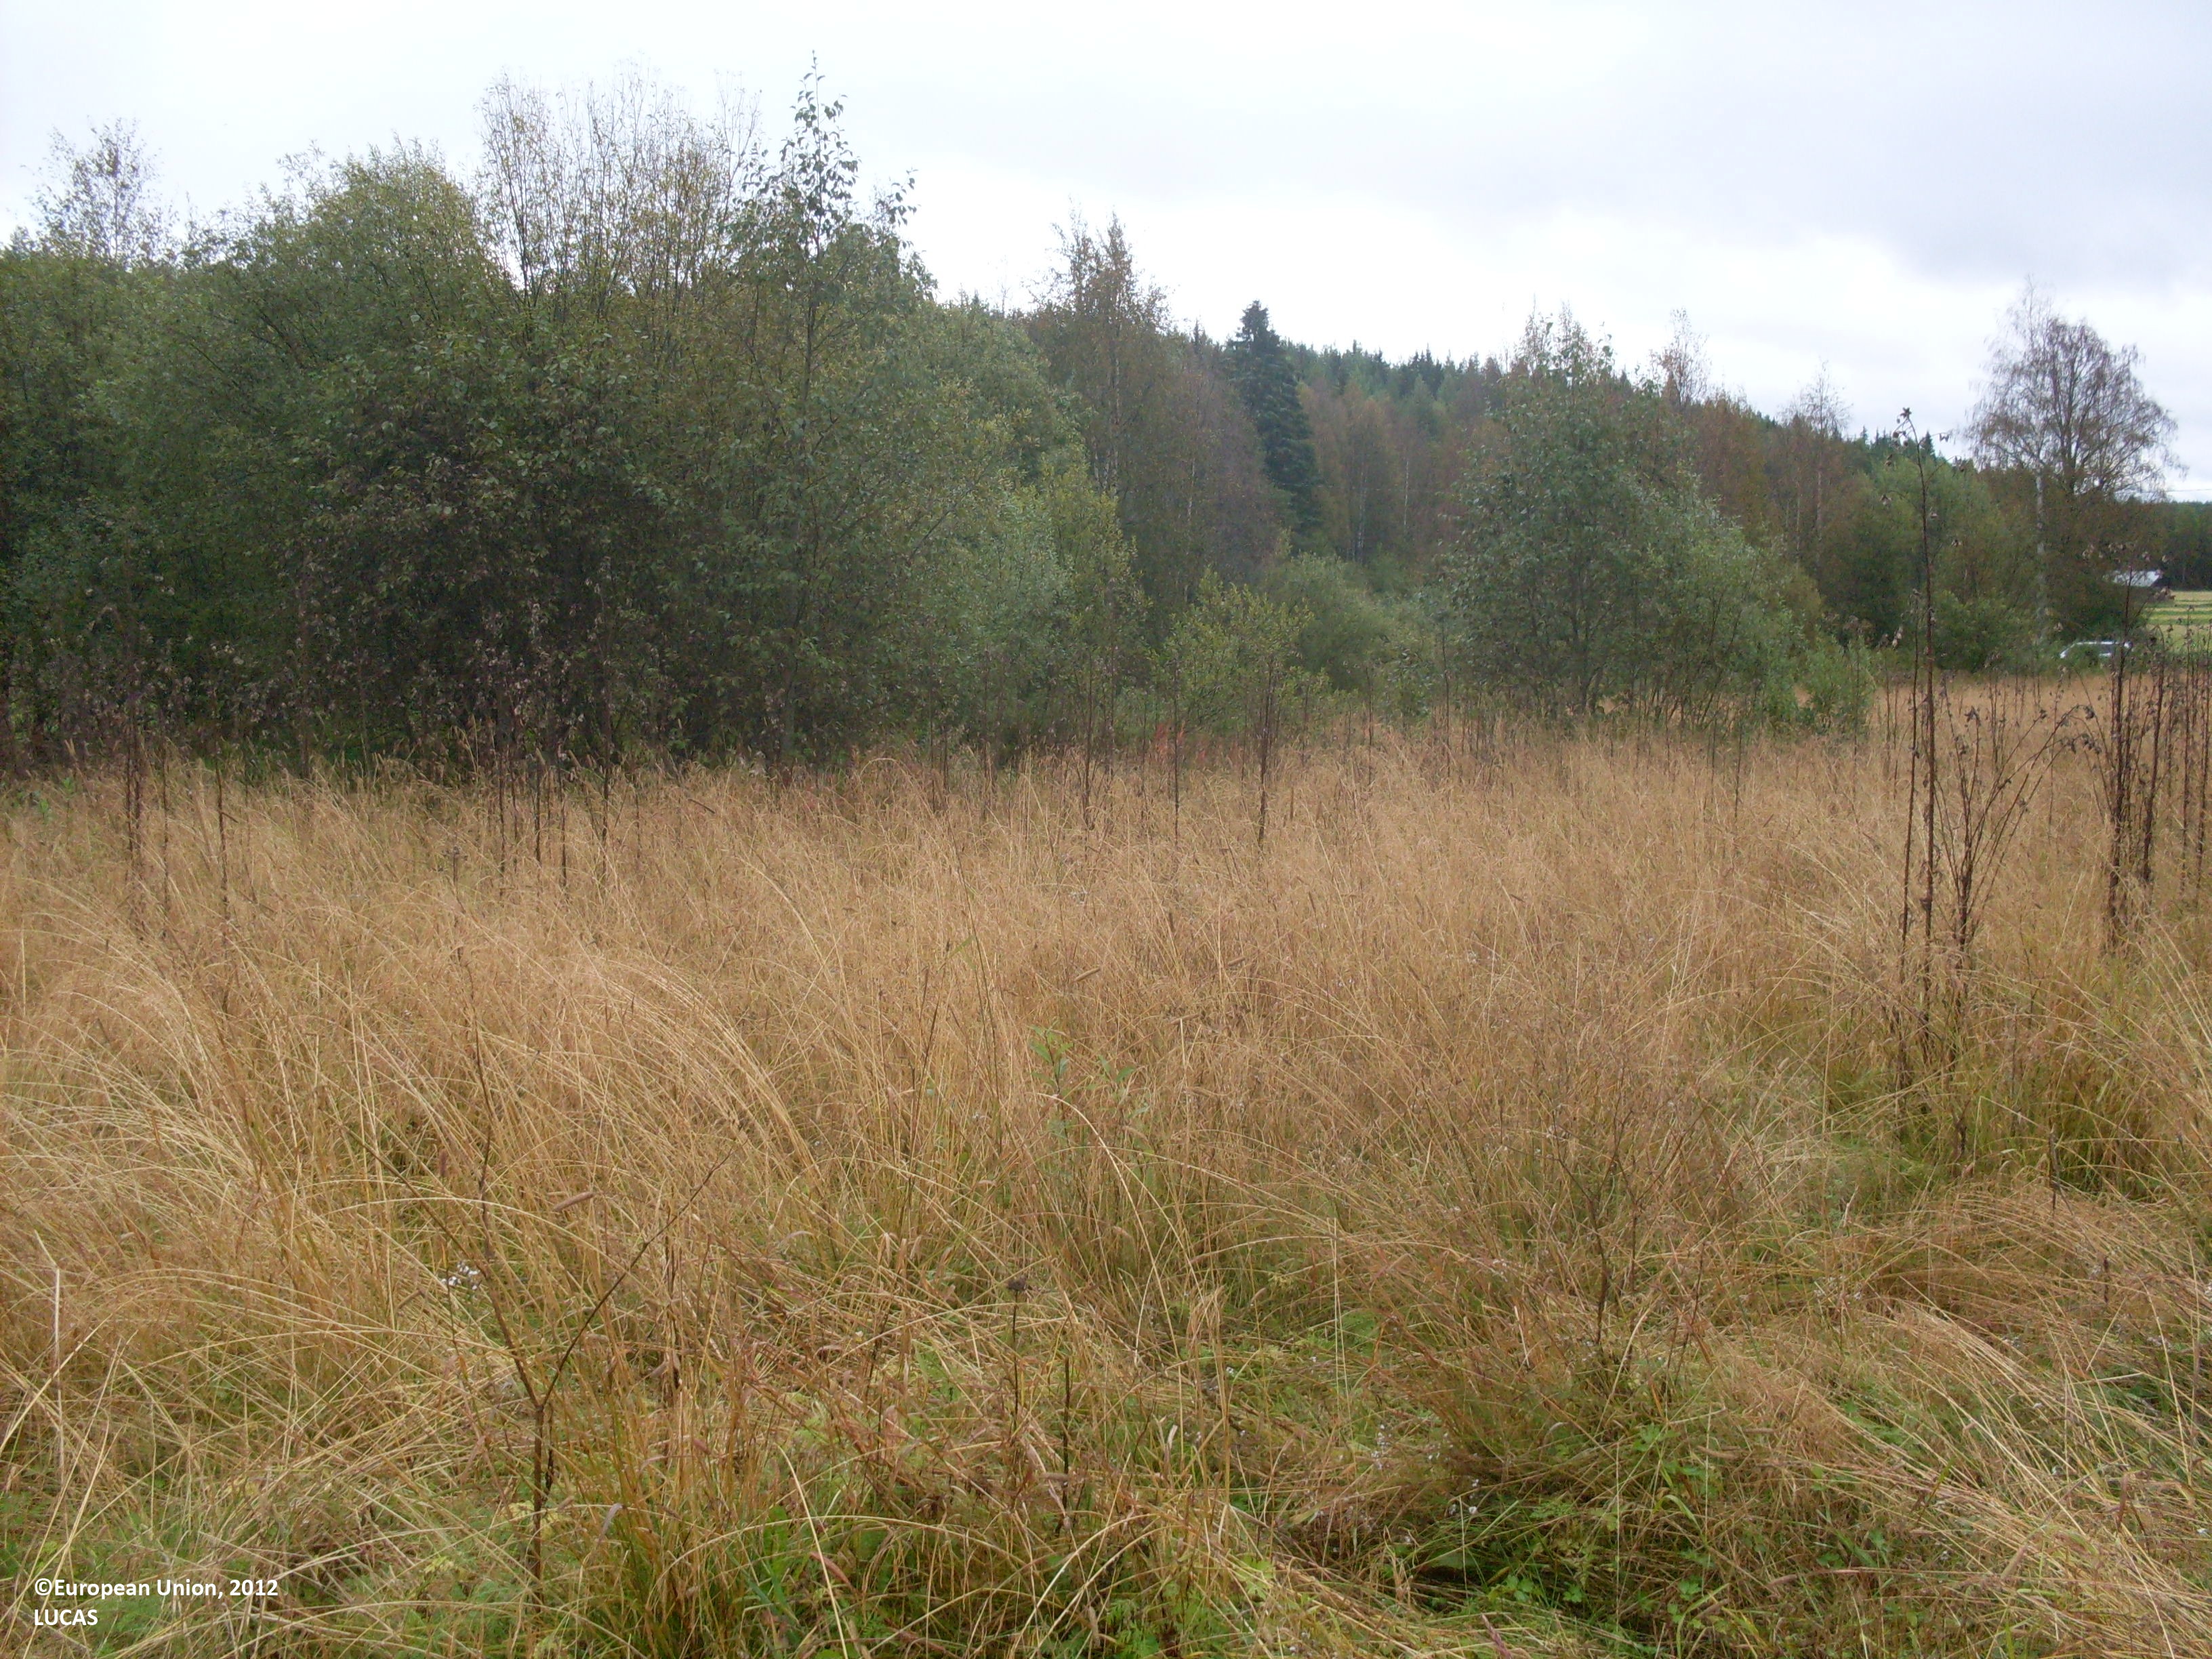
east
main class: Grassland
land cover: Grassland without tree/shrub cover
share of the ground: > 75 %
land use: Agriculture (excluding fallow land and kitchen gardens)
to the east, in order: Grassland without tree/shrub cover; Ditches and canals; Grass margins; Broadleaved woodland; Ditches and canals; Grassland without tree/shrub cover; Ditches and canals; Grass margins; Ditches and canals; Tracks; Ditches and canals; Grassland without tree/shrub cover; Ditches and canals; Broadleaved woodland; Ditches and canals; Grassland without tree/shrub cover; Ditches and canals; Pine dominated mixed woodland
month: September
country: FI
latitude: 64.1477
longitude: 29.6054
